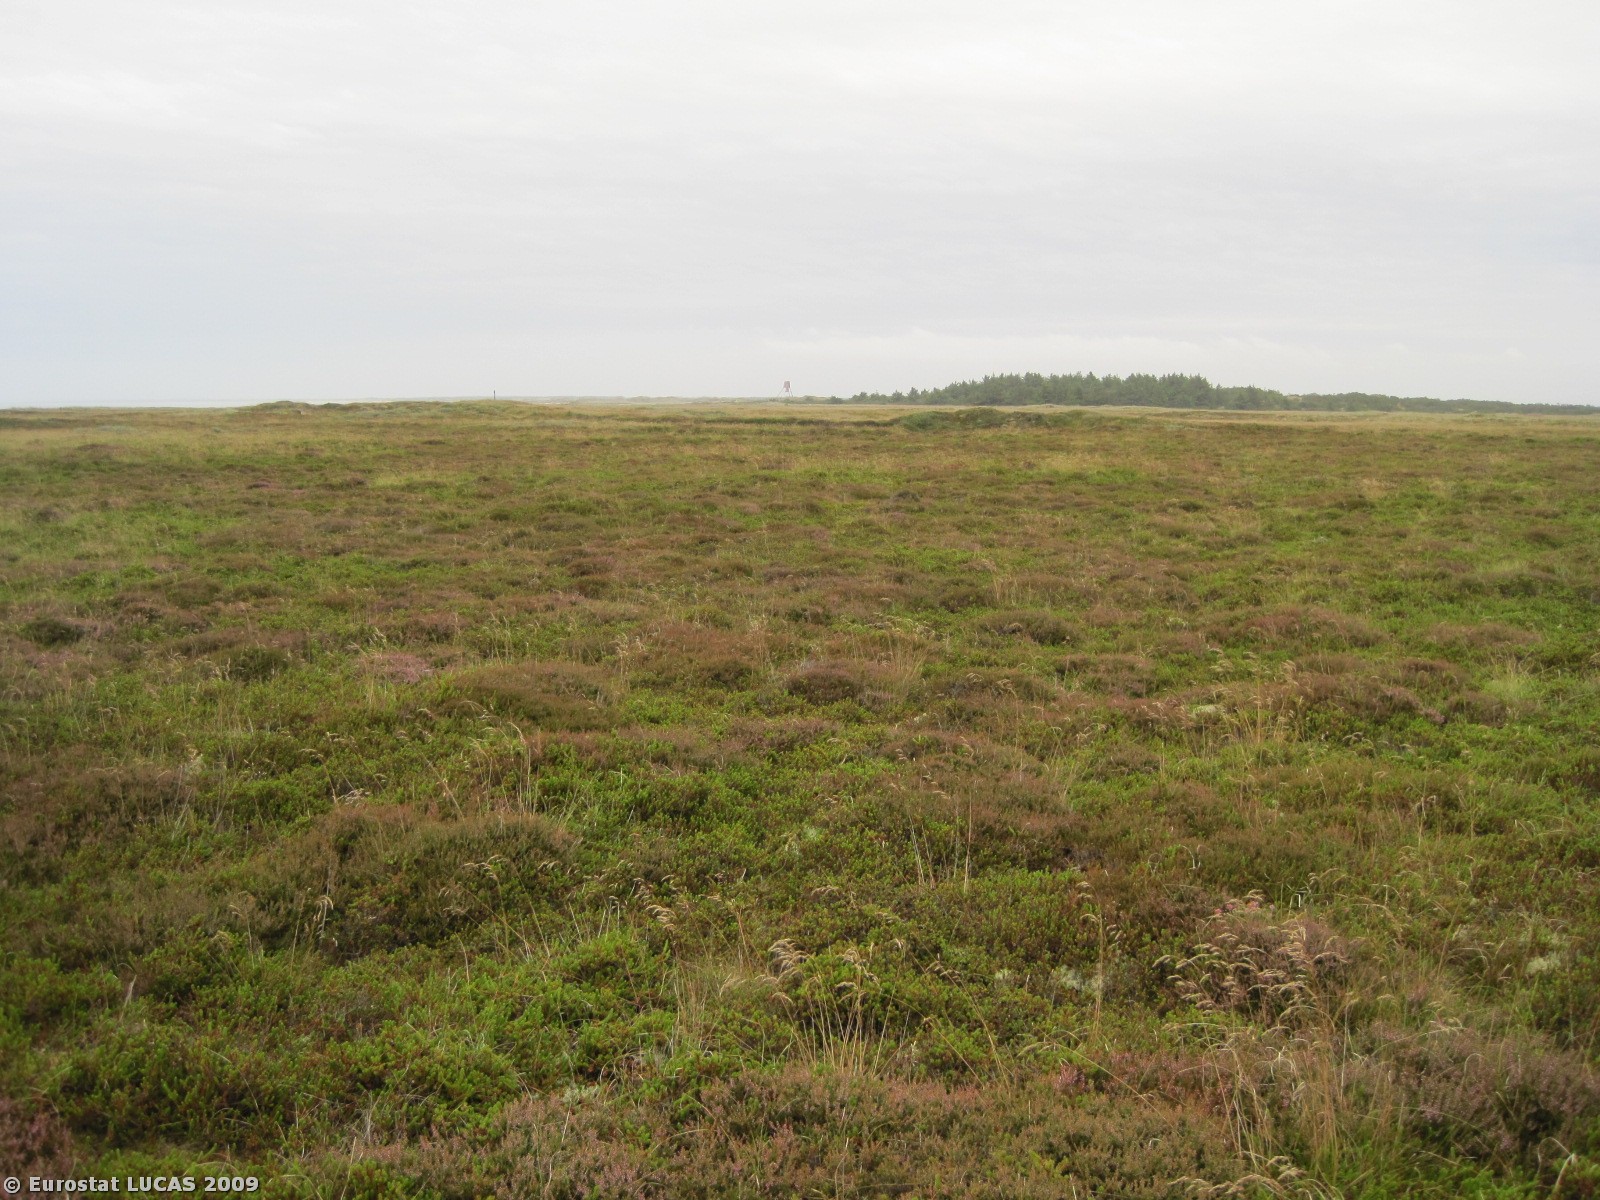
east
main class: Grassland
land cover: Grassland without tree/shrub cover
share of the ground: > 75 %
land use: Nature reserves
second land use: Amenities, museums, leisure
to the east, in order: Grassland without tree/shrub cover
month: July
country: DK
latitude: 57.0984
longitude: 8.7309
